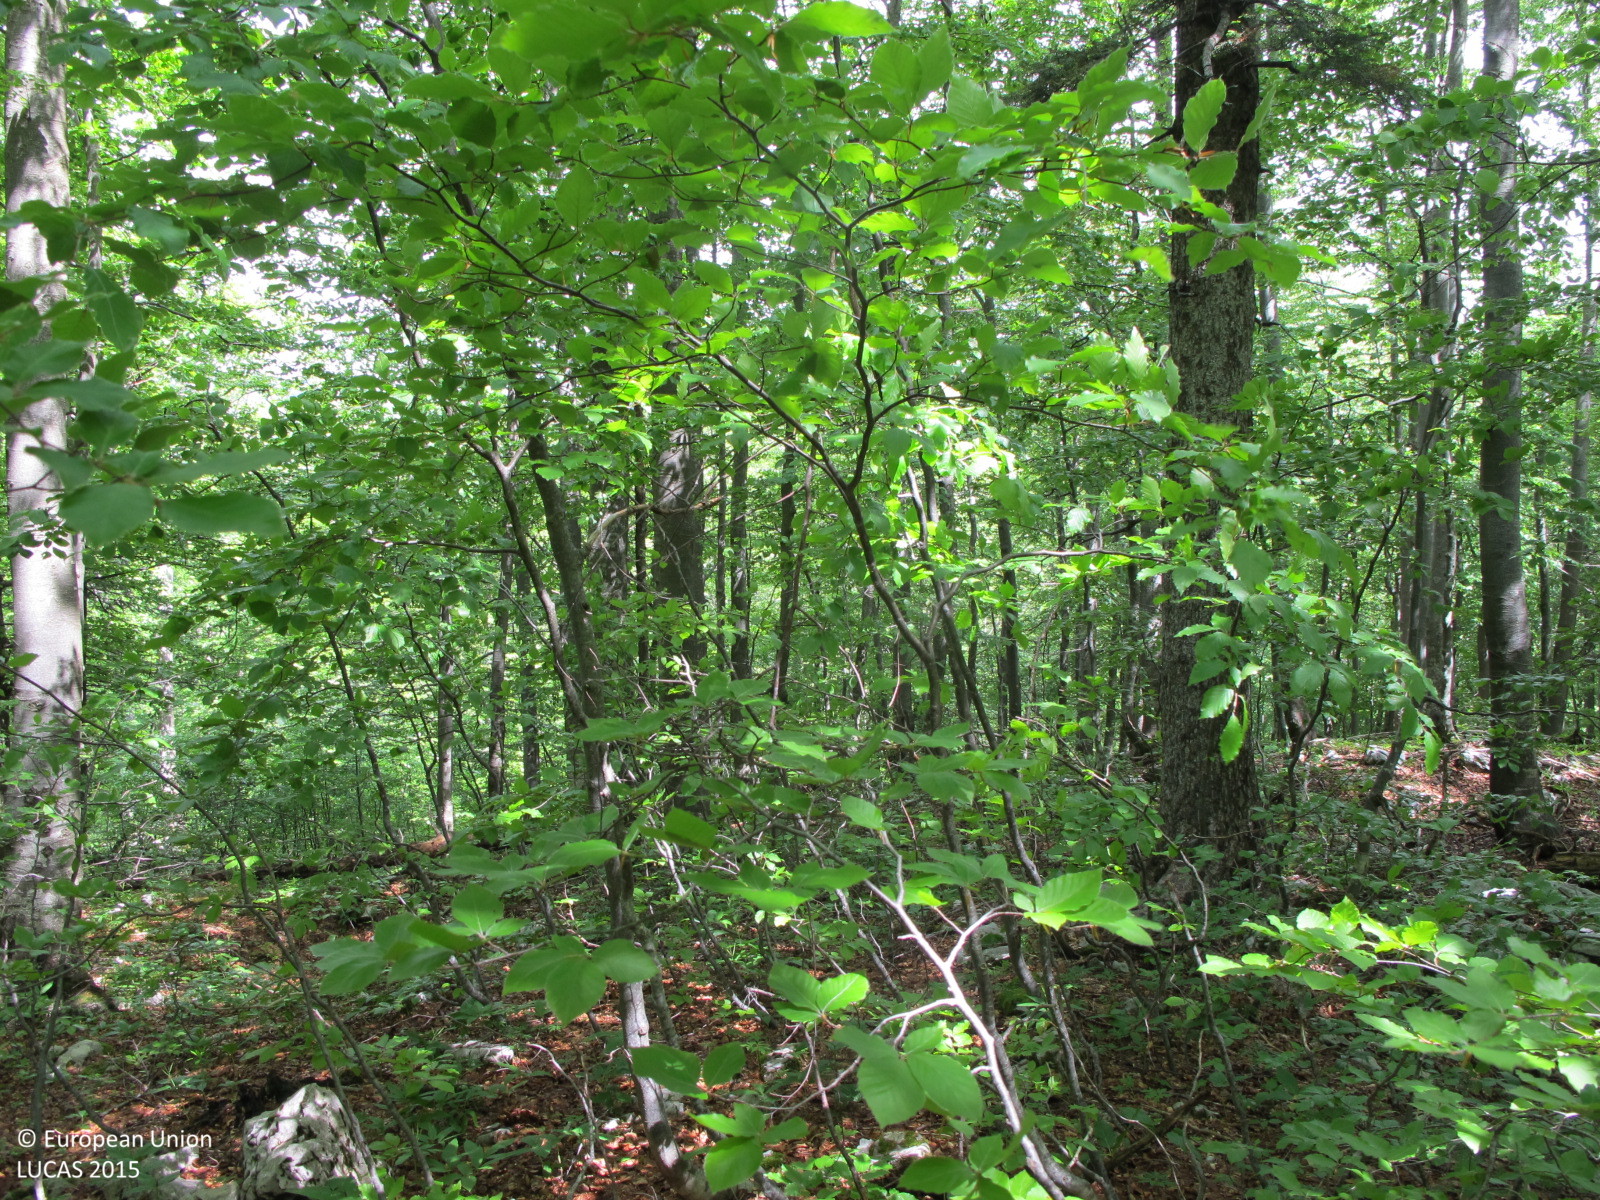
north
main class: Woodland
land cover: Broadleaved woodland
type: mountainous beech forest
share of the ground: > 75 %
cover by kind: broadleaved forest trees 90 %, coniferous forest trees 5 %, shrubs 5 %
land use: Forestry
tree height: > 5 m
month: May
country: HR
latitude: 45.4611
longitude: 14.5353
